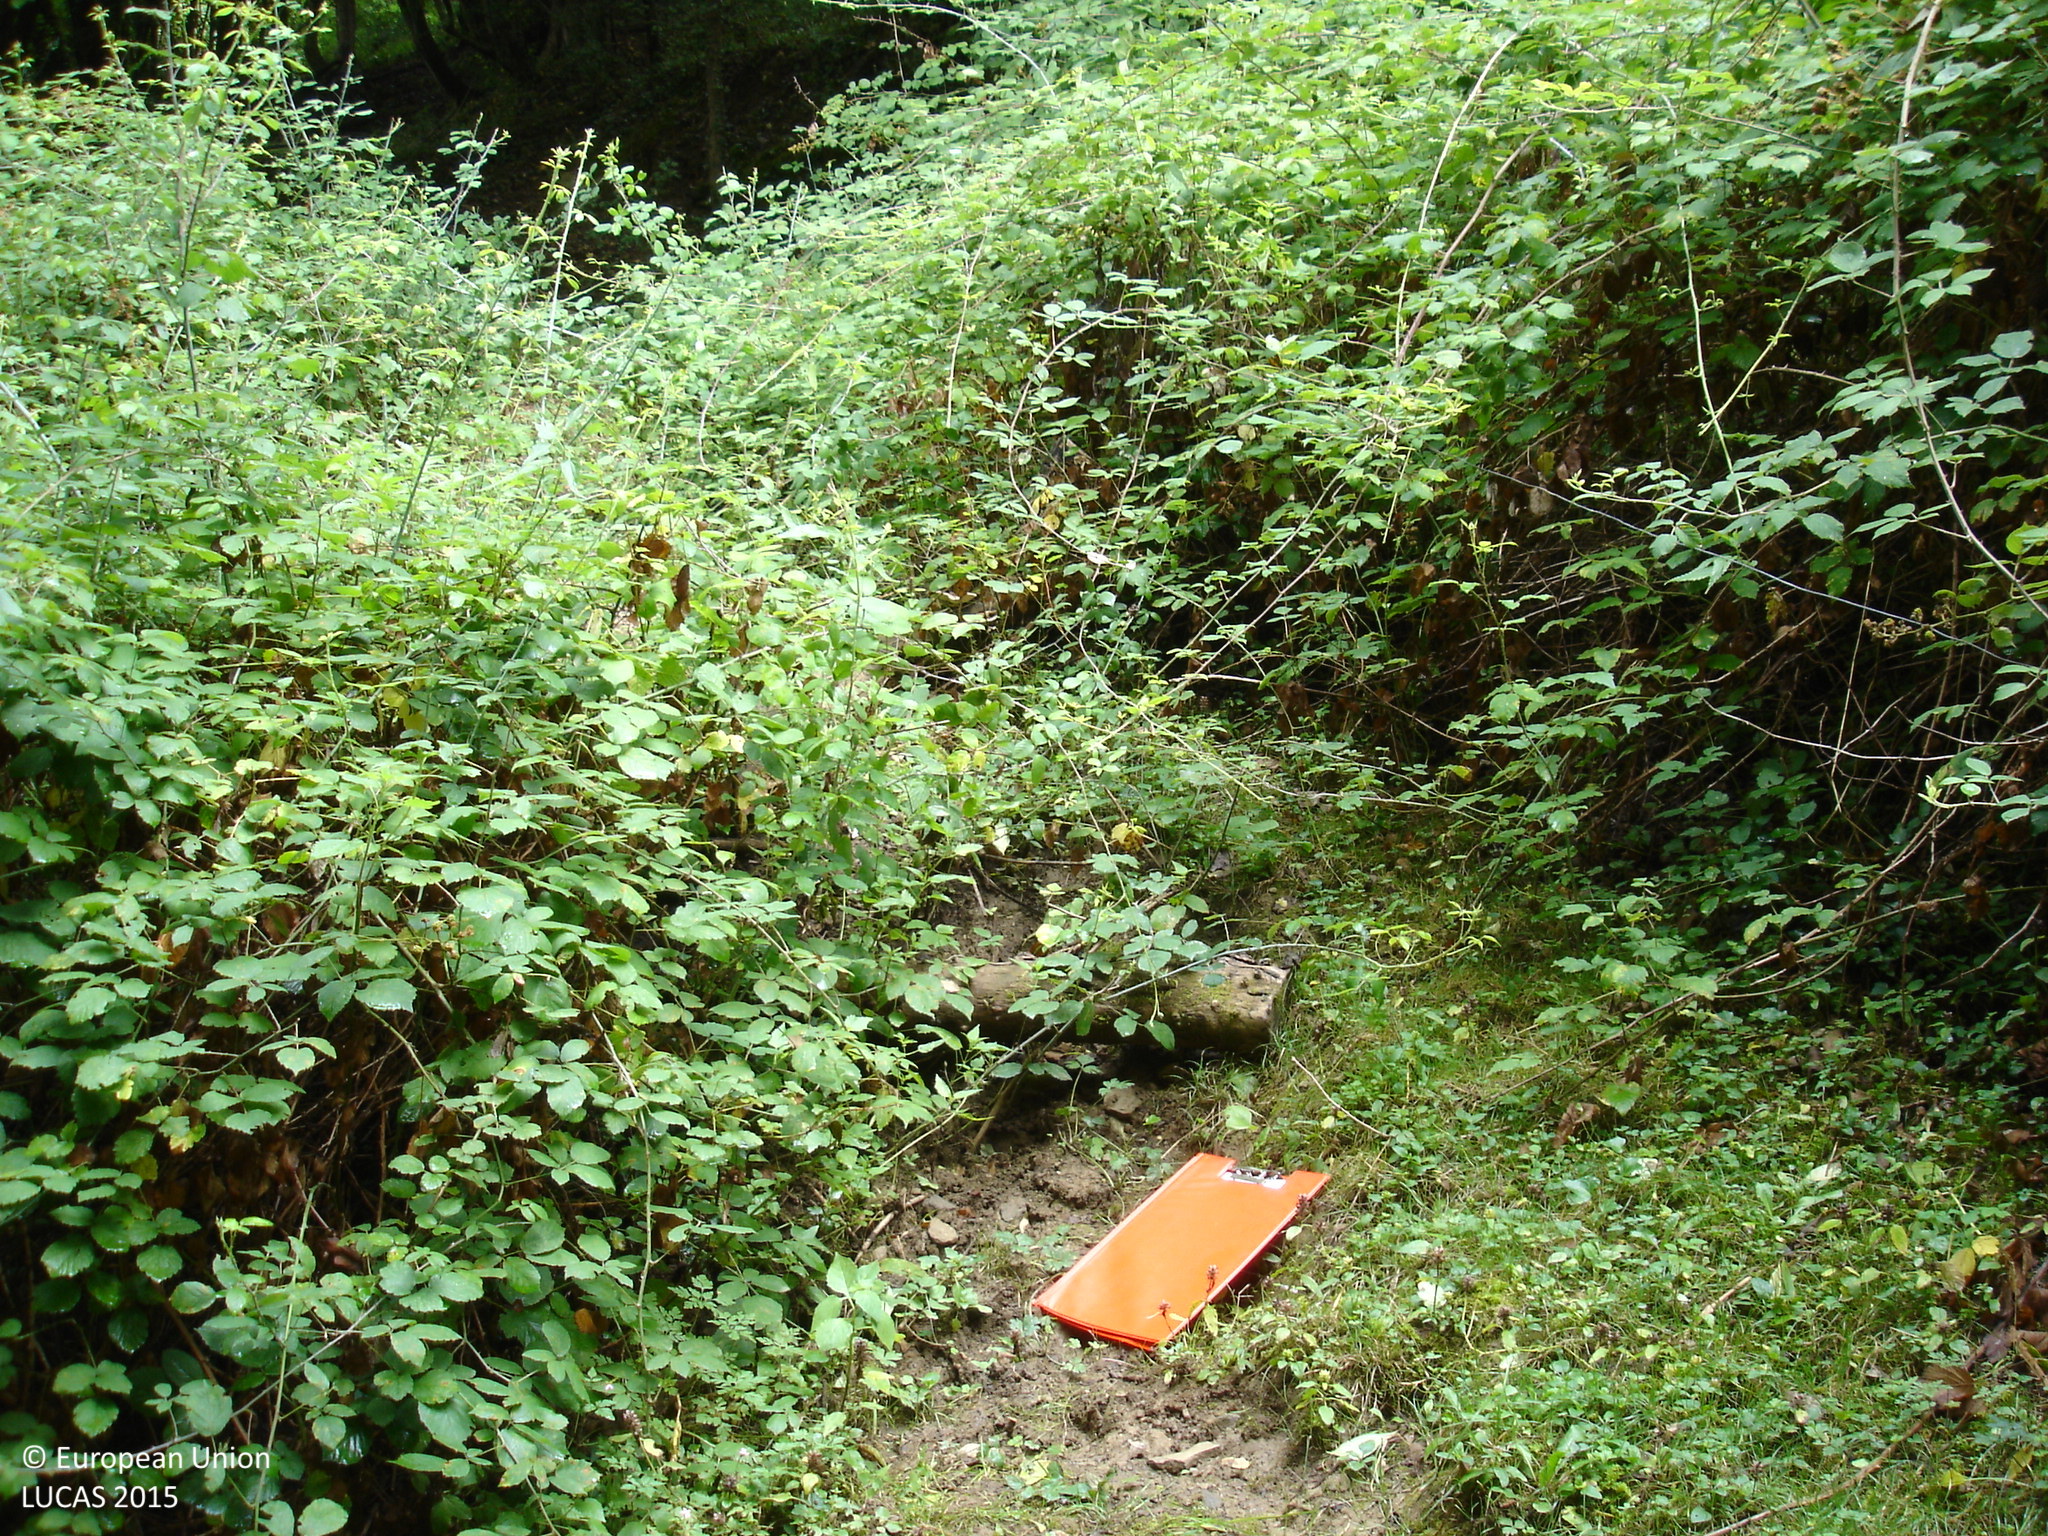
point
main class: Woodland
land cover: Broadleaved woodland
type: thermophilous deciduous forest
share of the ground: > 75 %
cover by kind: broadleaved forest trees 80 %, shrubs 15 %, herbaceous plants 5 %
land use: Semi-natural and natural areas not in use
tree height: > 5 m
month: July
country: ES
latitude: 42.1418
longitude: 2.5245
